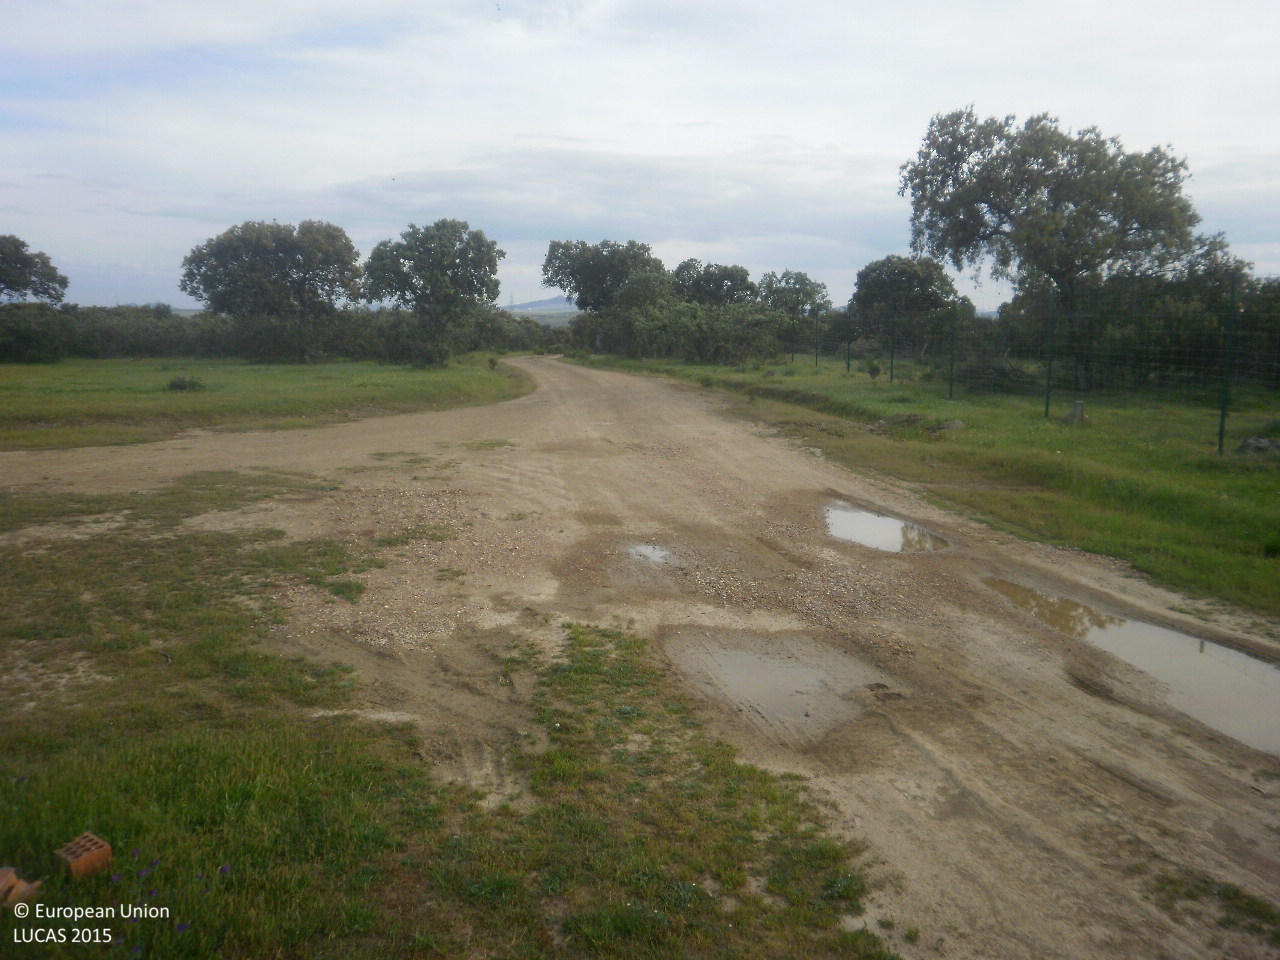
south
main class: Woodland
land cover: Broadleaved woodland
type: broadleaved evergreen forest
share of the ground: 50 - 75 %
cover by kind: broadleaved forest trees 50 %, shrubs 35 %, herbaceous plants 15 %
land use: Agriculture (excluding fallow land and kitchen gardens)
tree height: > 5 m
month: April
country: ES
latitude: 39.1185
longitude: -5.2744
